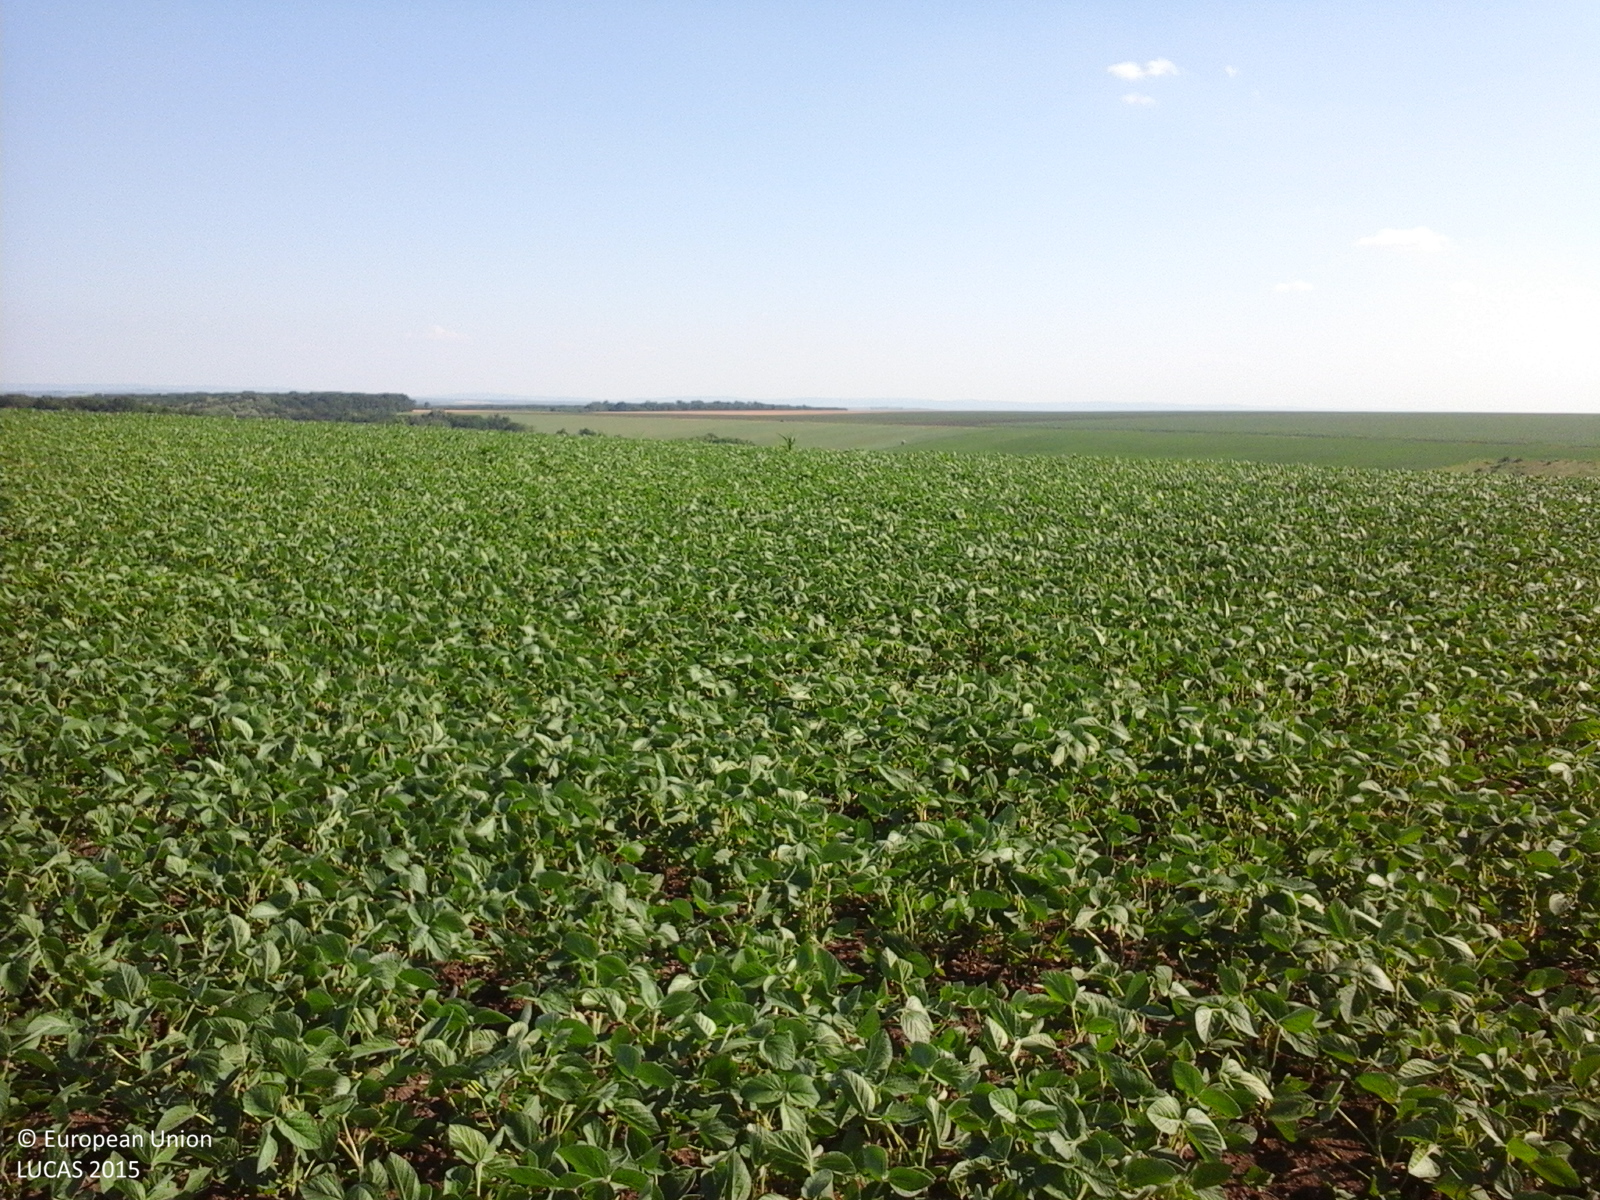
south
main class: Cropland
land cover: Soya
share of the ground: 50 - 75 %
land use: Agriculture (excluding fallow land and kitchen gardens)
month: June
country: RO
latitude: 47.4085
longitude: 27.4363
